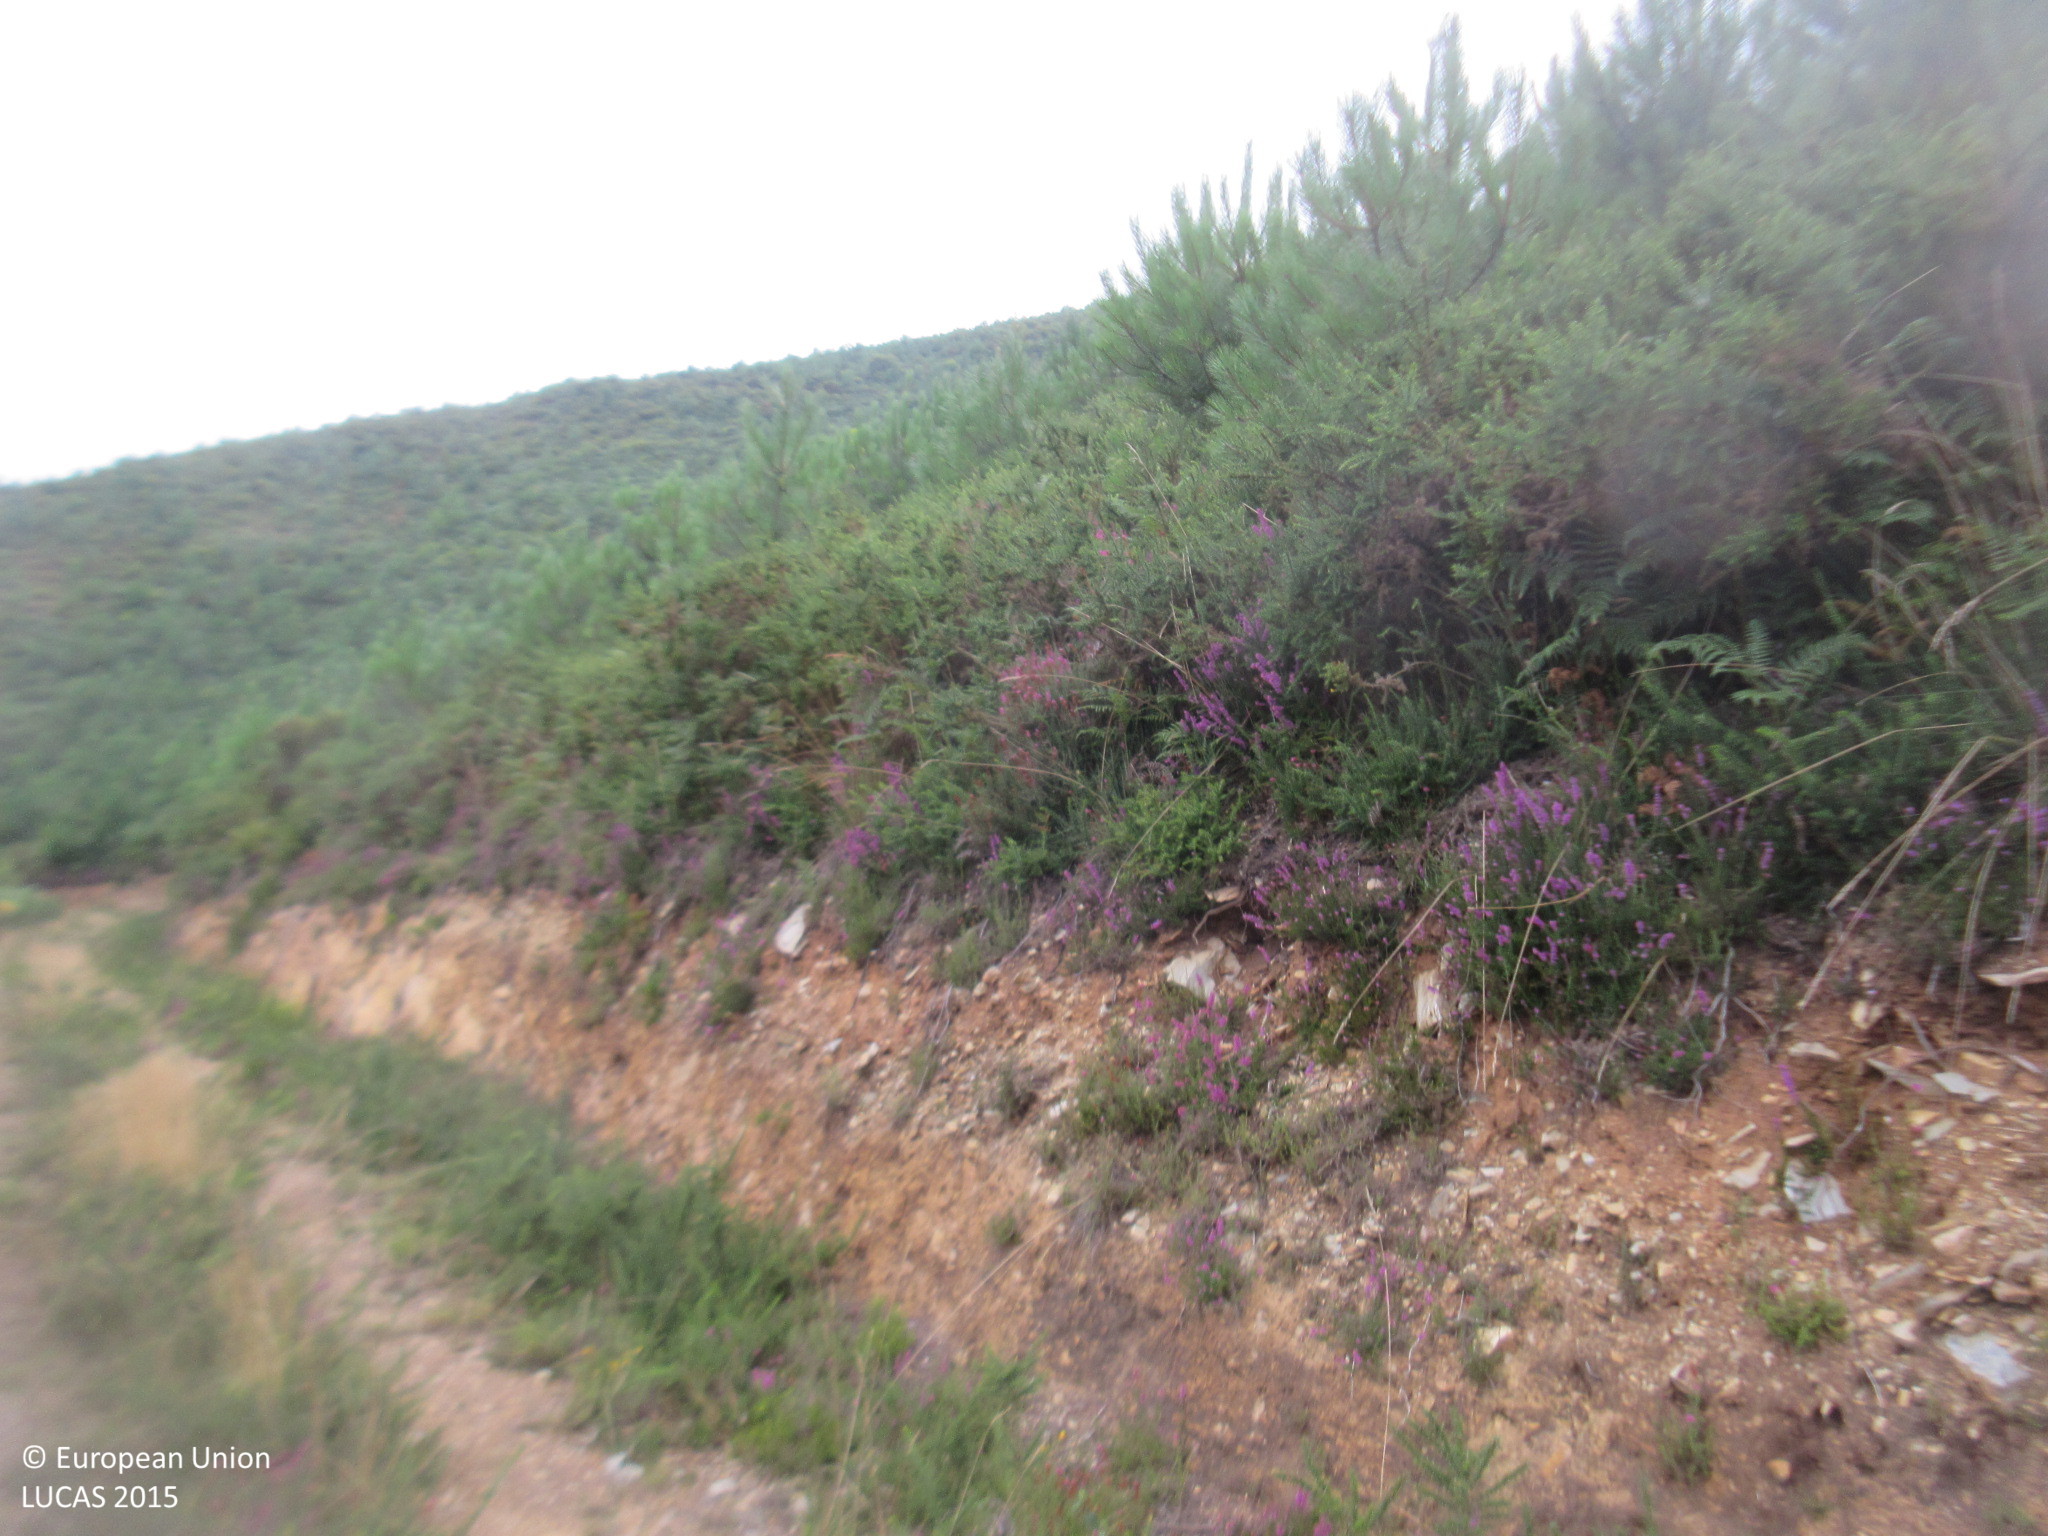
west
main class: Woodland
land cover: Pine dominated coniferous woodland
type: hemiboreal forest and nemoral coniferous forest and mixed broadleaved-coniferous forest
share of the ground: 50 - 75 %
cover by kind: coniferous forest trees 50 %, shrubs 50 %
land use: Forestry
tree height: > 5 m
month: August
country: ES
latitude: 43.4260
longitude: -6.3687
